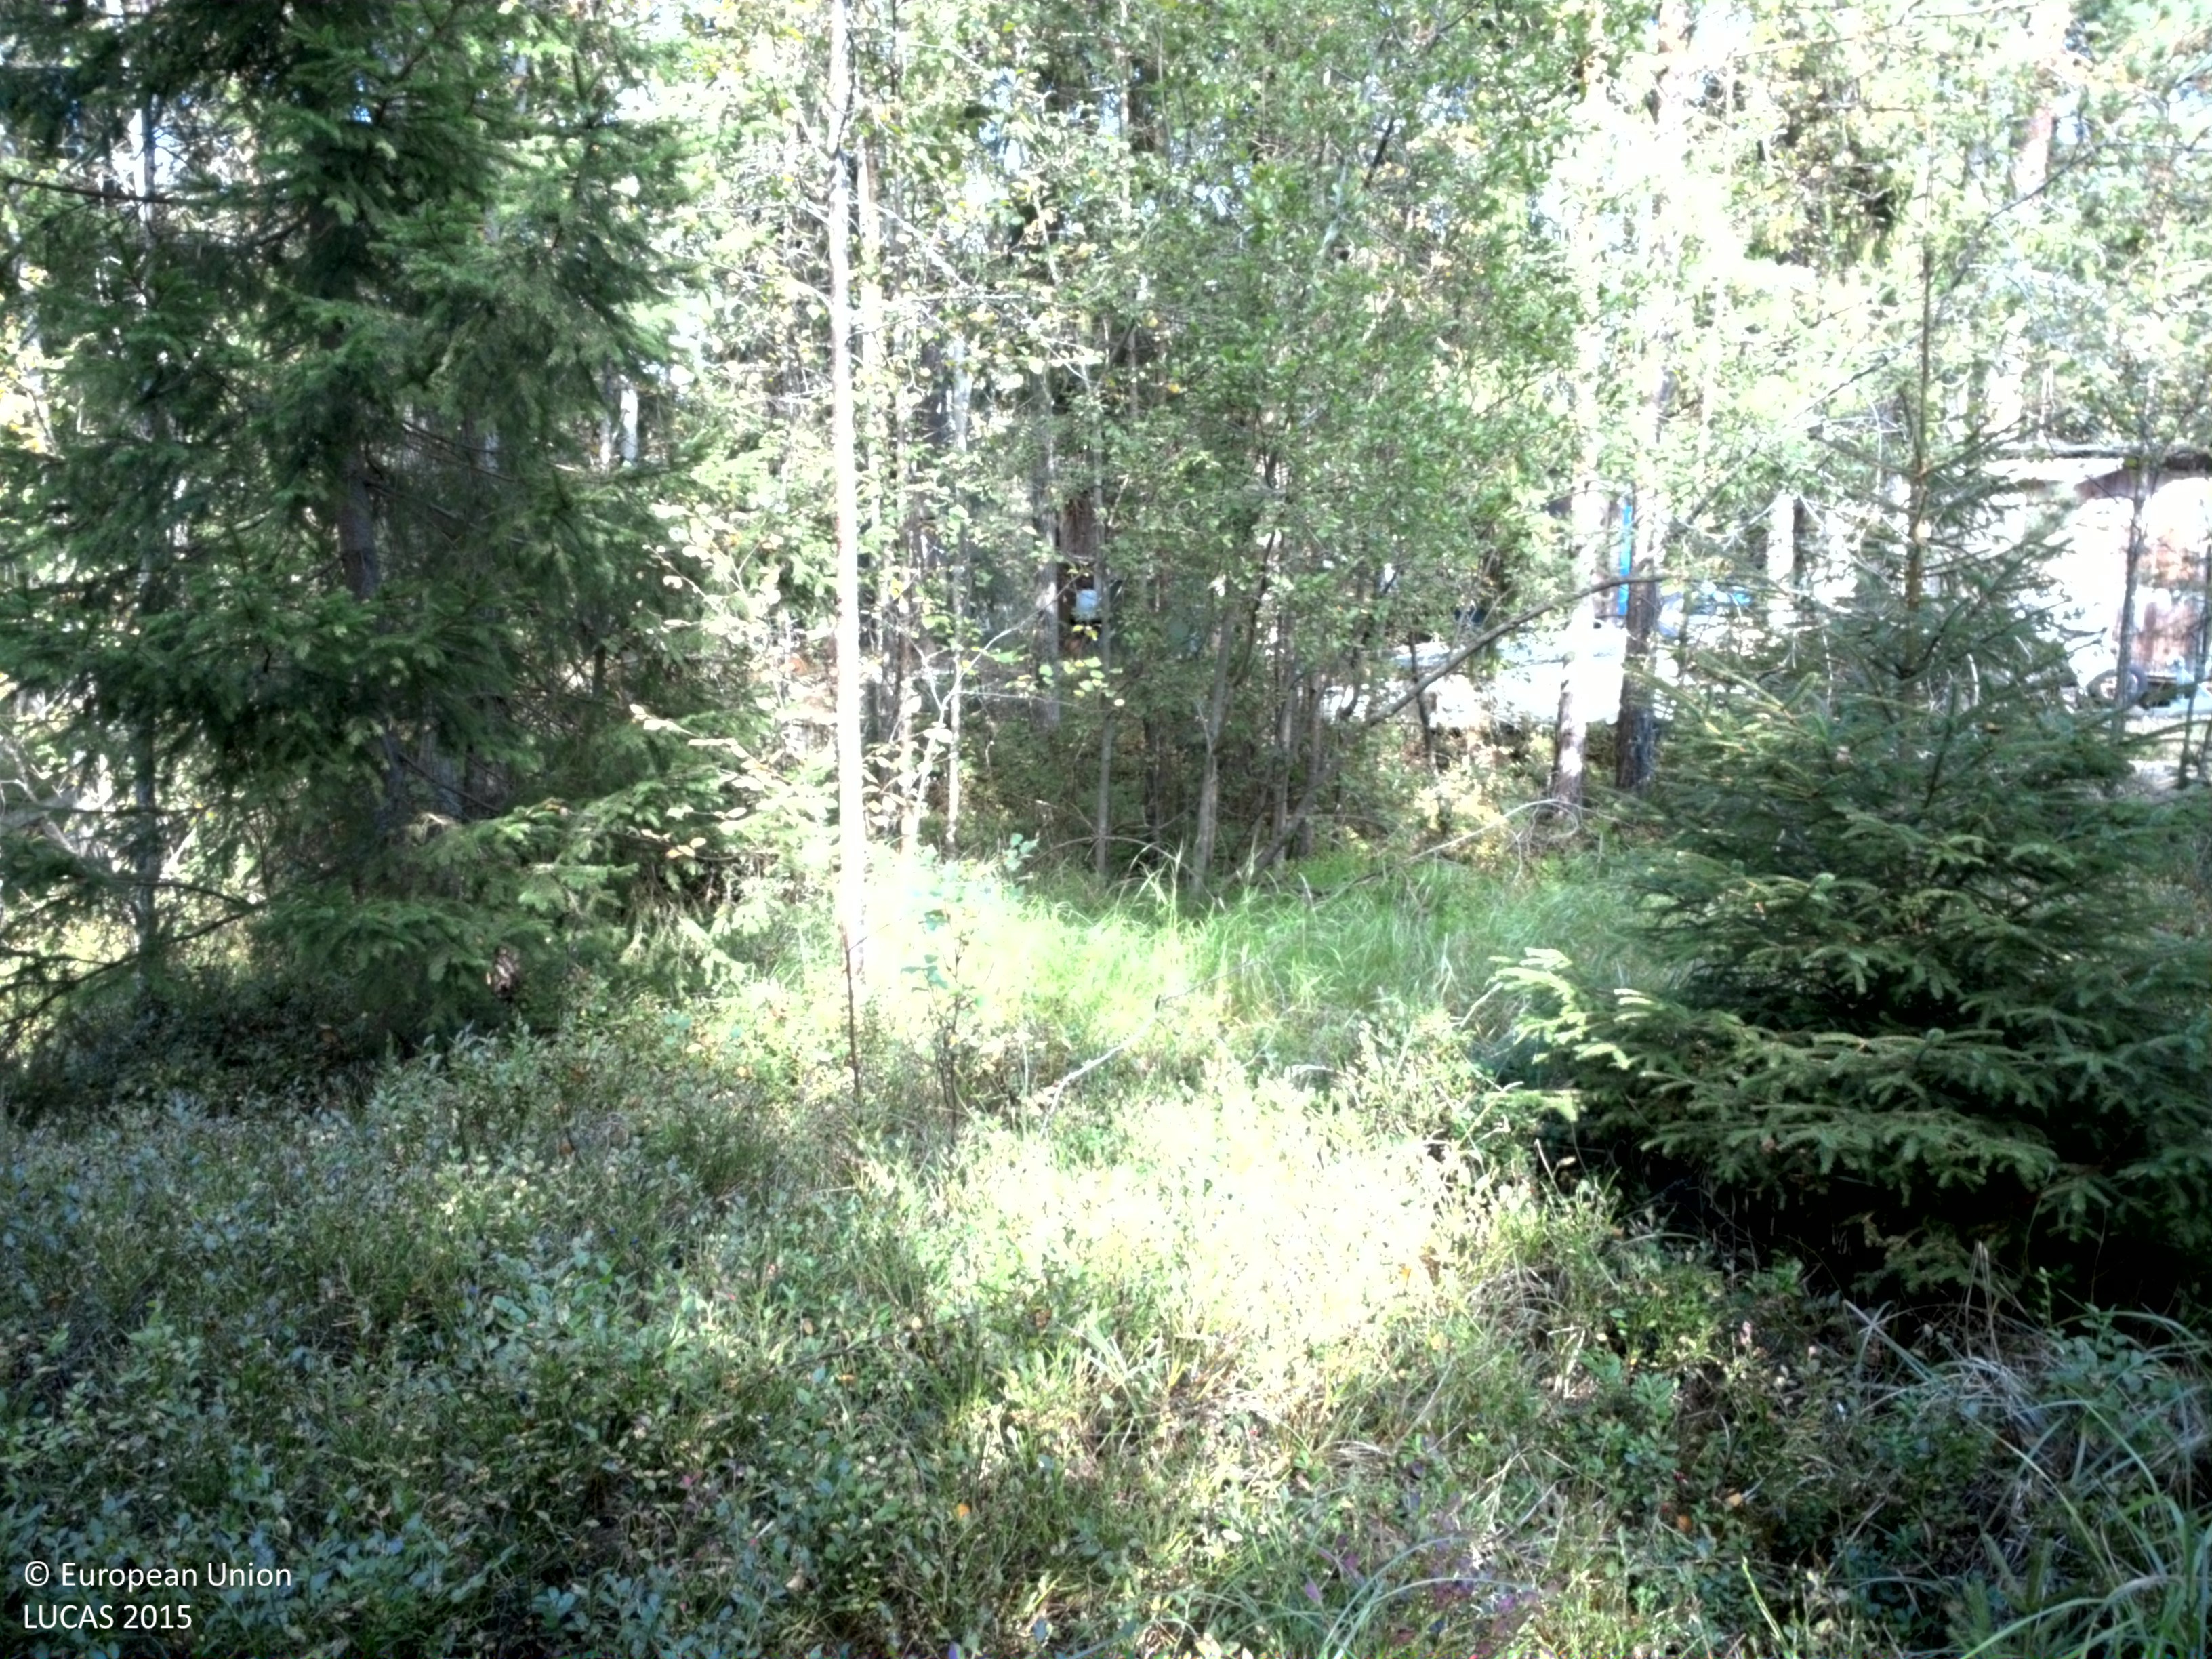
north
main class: Woodland
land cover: Spruce dominated coniferous woodland
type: boreal forest
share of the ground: 50 - 75 %
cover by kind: coniferous forest trees 60 %, broadleaved forest trees 15 %, shrubs 15 %, lichens and mosses 10 %
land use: Forestry
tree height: > 5 m
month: September
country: SE
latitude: 59.2754
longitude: 18.4414
